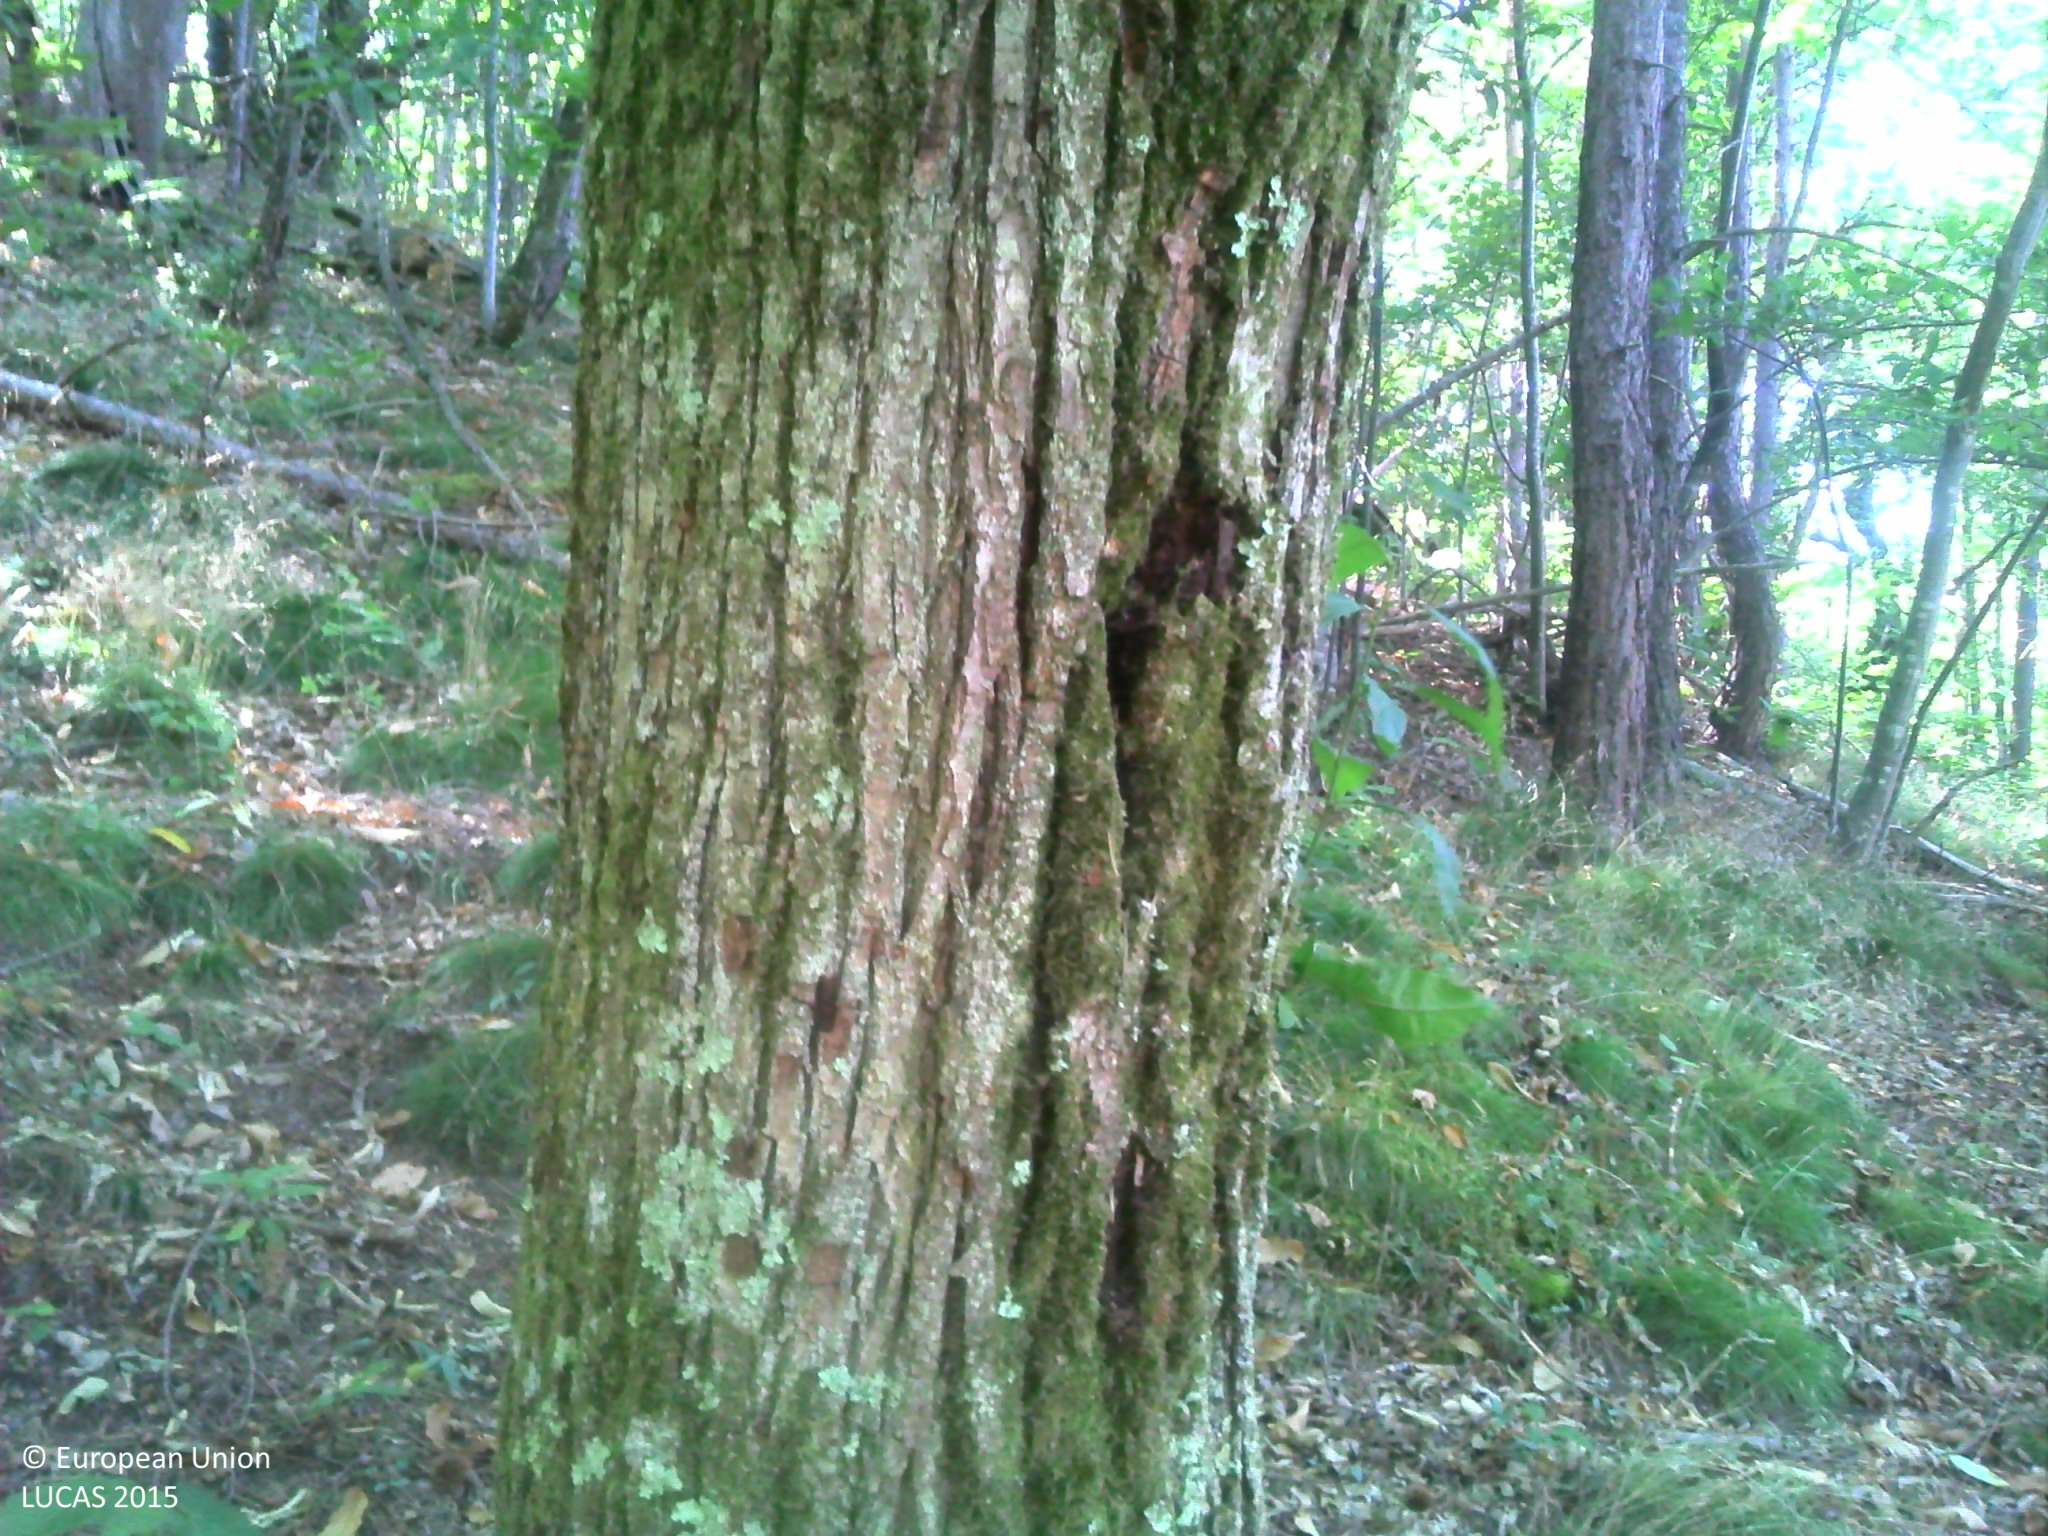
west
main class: Woodland
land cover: Broadleaved woodland
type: thermophilous deciduous forest
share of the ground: > 75 %
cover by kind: broadleaved forest trees 80 %, herbaceous plants 10 %, lichens and mosses 10 %
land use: Forestry
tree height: > 5 m
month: July
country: FR
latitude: 44.9671
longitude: 4.5662
